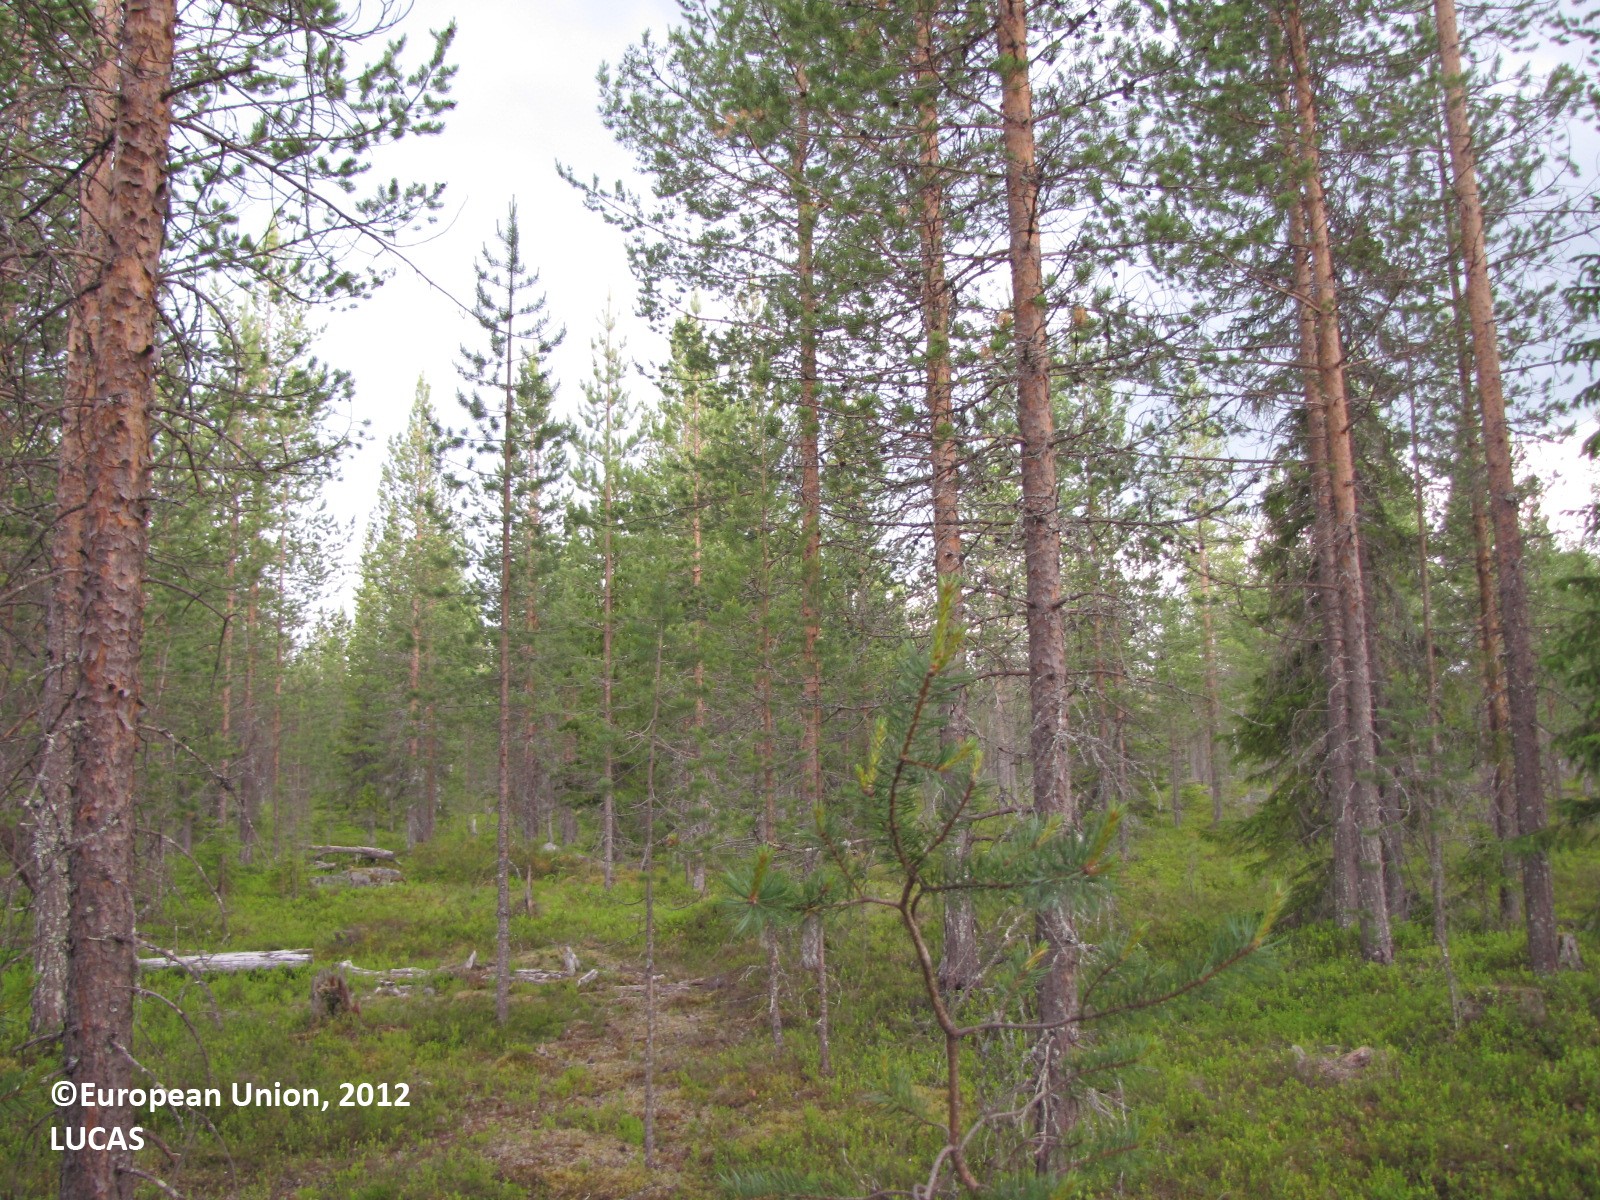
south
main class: Woodland
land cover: Pine dominated coniferous woodland
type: boreal forest
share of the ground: 50 - 75 %
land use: Forestry
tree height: > 5 m
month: July
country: FI
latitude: 66.3958
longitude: 25.2110
